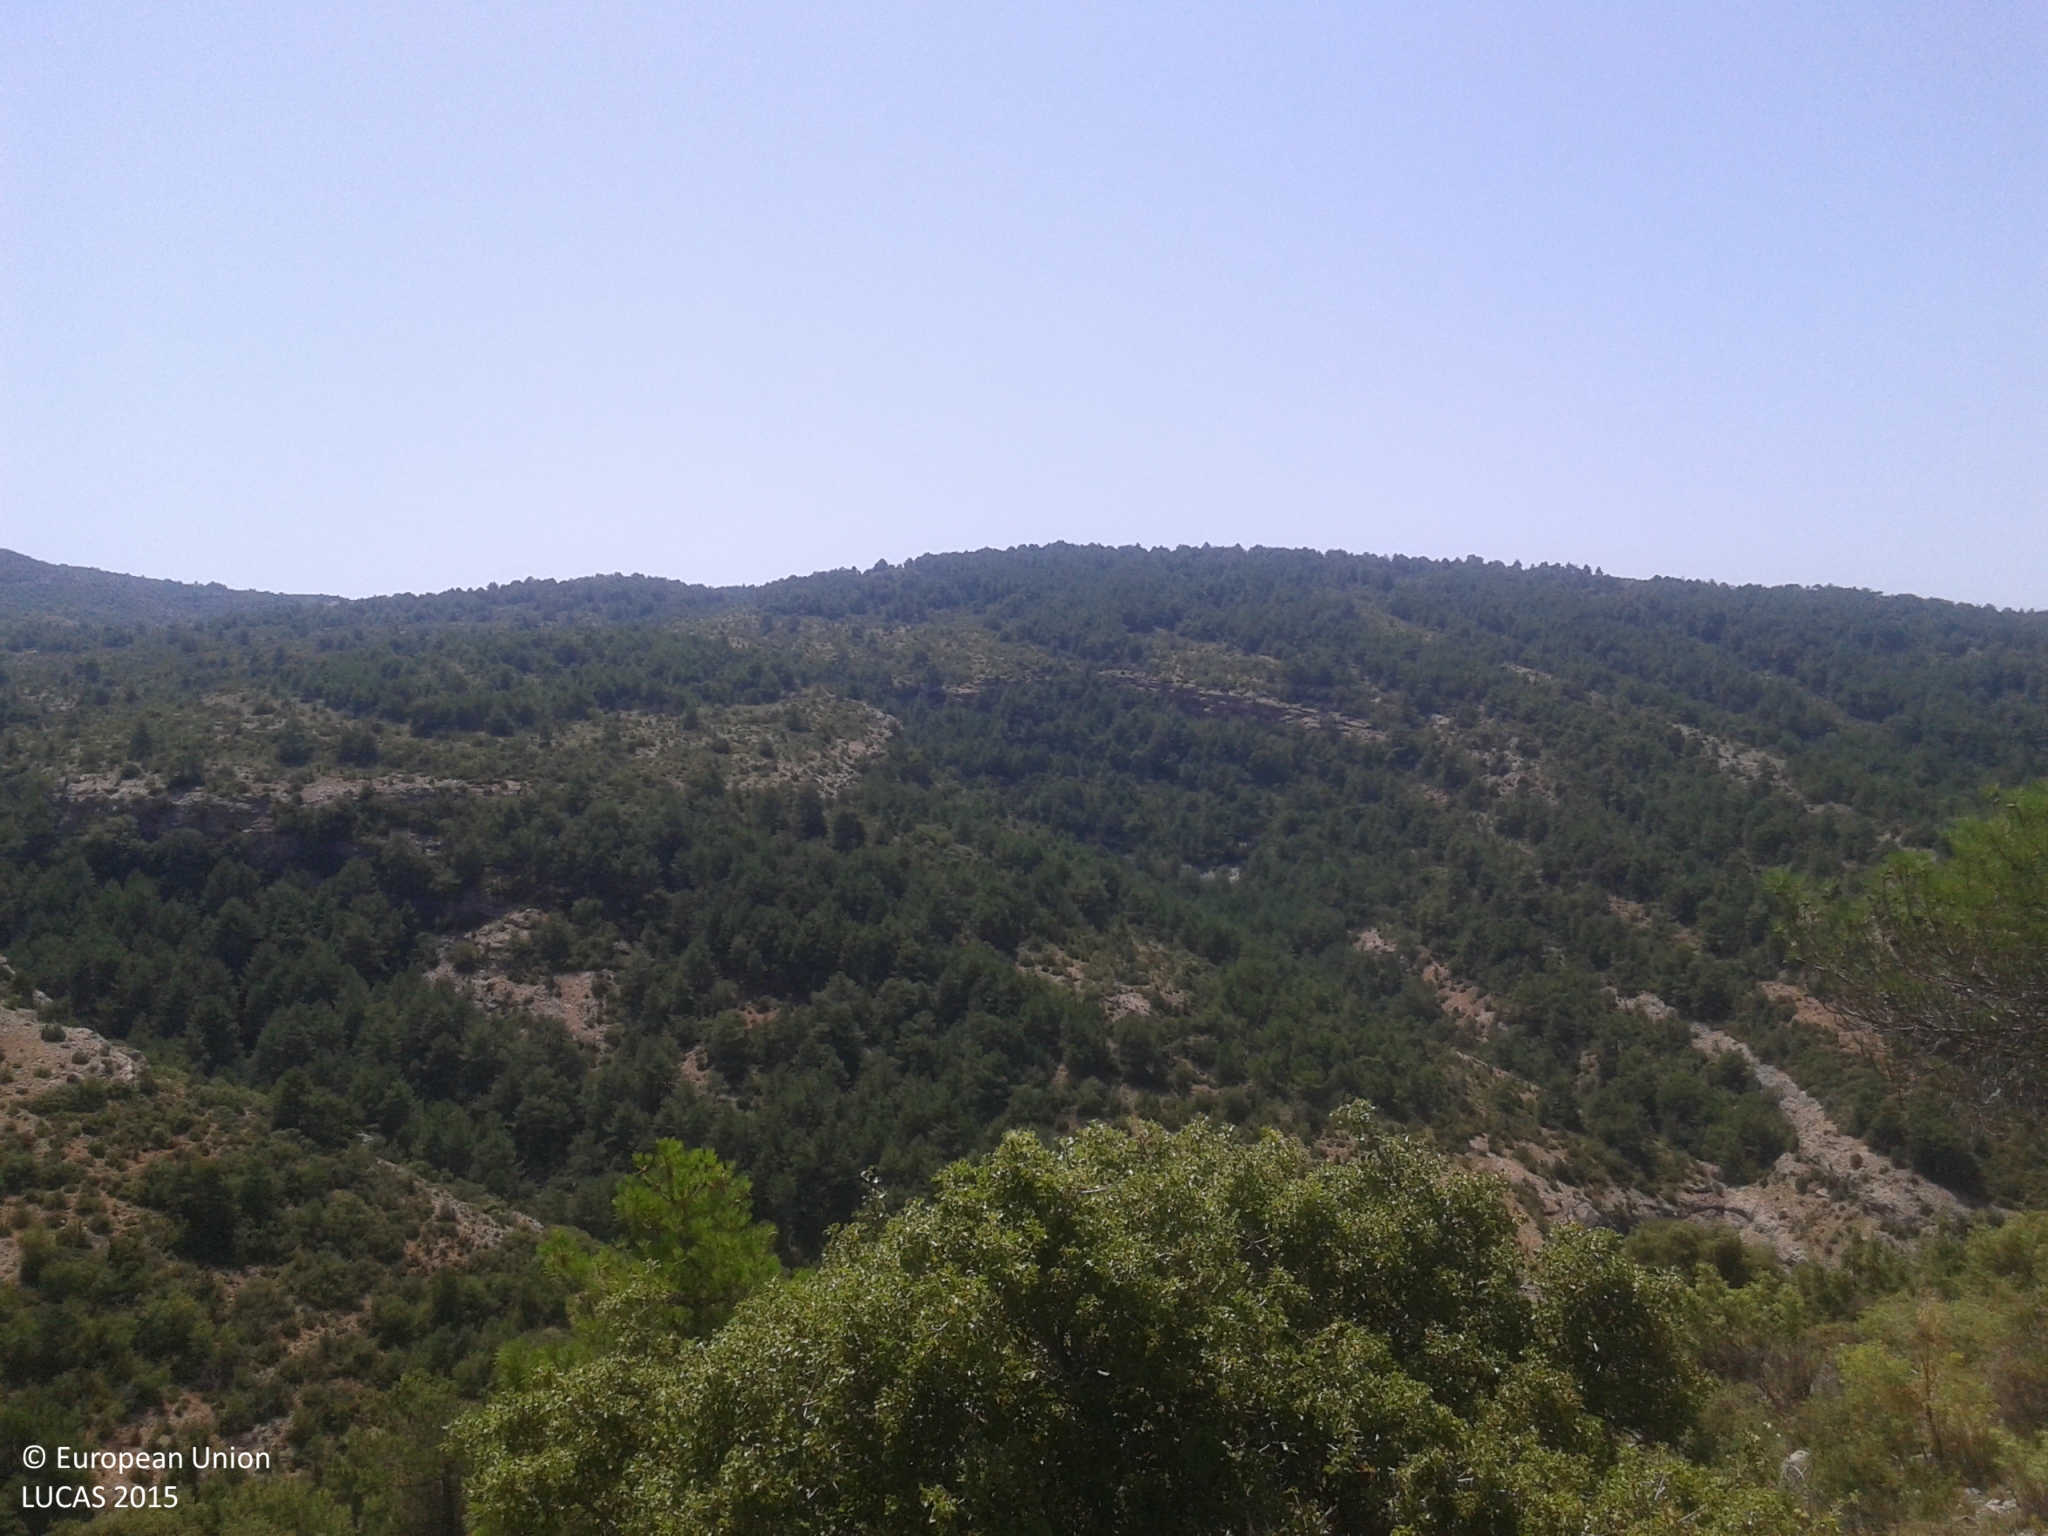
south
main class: Shrubland
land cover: Shrubland with sparse tree cover
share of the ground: 50 - 75 %
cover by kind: shrubs 60 %, consolidated bare surface 30 %, coniferous forest trees 5 %, herbaceous plants 5 %
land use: Semi-natural and natural areas not in use
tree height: < 5 m
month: August
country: ES
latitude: 42.2192
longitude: 1.0324
